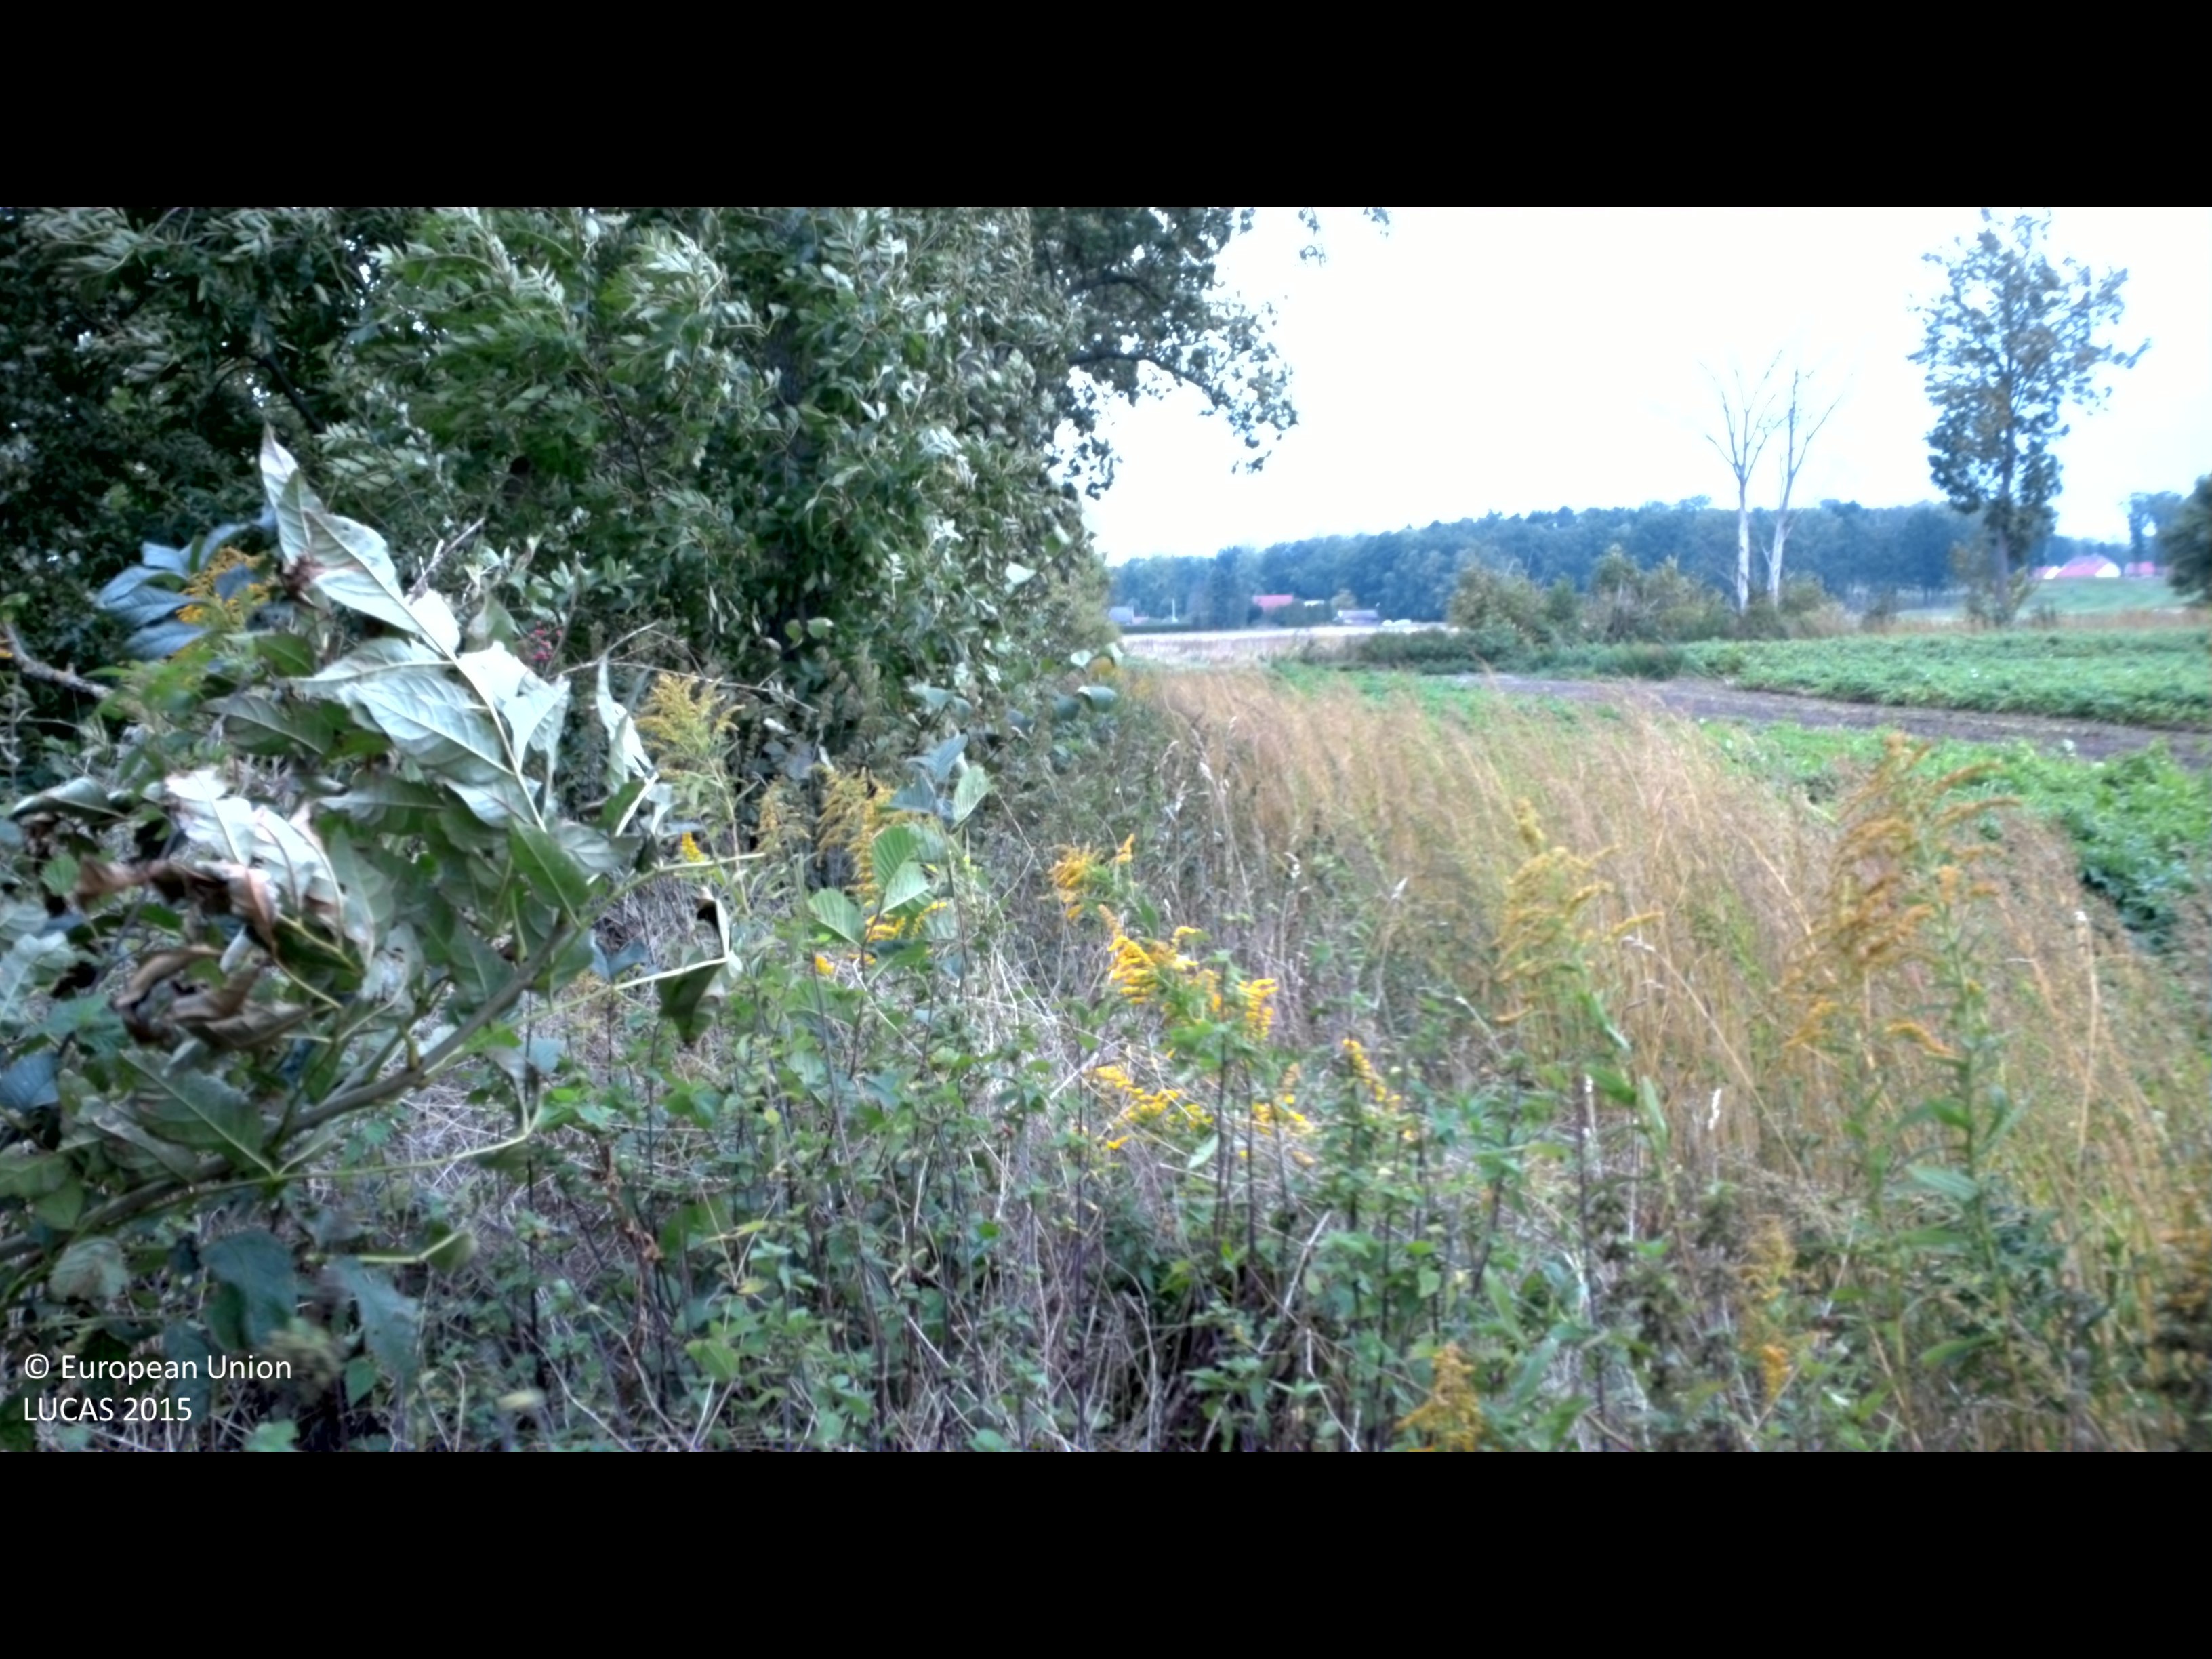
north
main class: Cropland
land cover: Potatoes
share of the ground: > 75 %
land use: Agriculture (excluding fallow land and kitchen gardens)
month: September
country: SE
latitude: 56.0506
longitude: 14.0921
